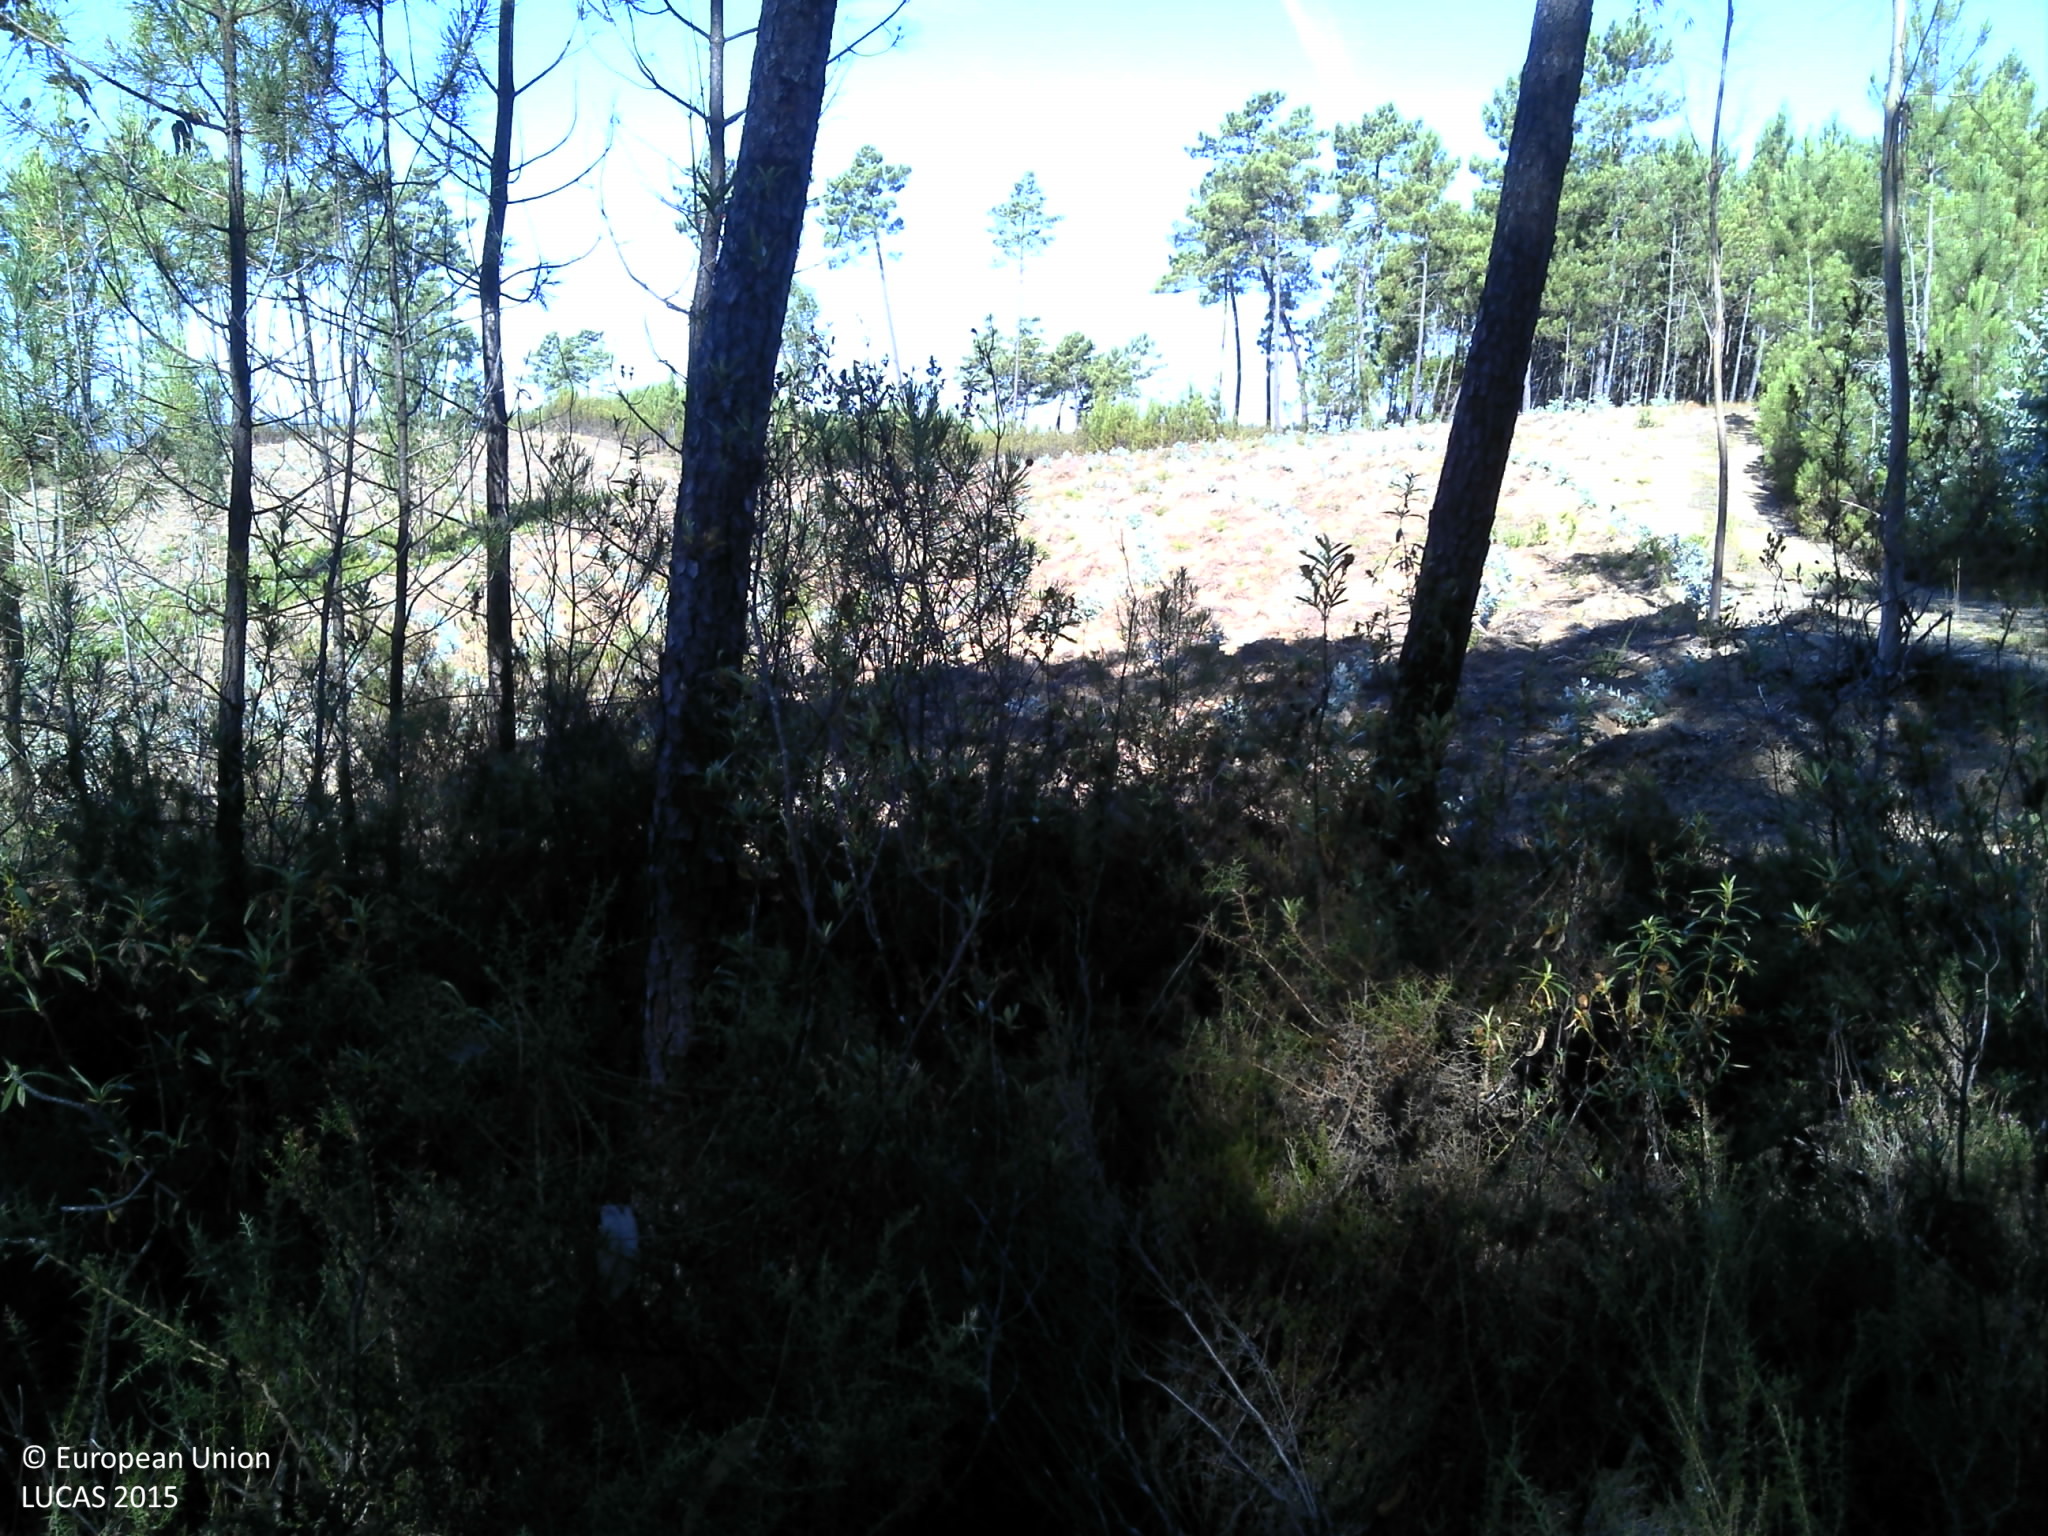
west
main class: Woodland
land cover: Pine dominated coniferous woodland
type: coniferous forest of the mediterranean region
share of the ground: 10 - 25 %
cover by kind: shrubs 70 %, coniferous forest trees 30 %
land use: Forestry
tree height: > 5 m
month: July
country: PT
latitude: 39.7731
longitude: -8.0804
